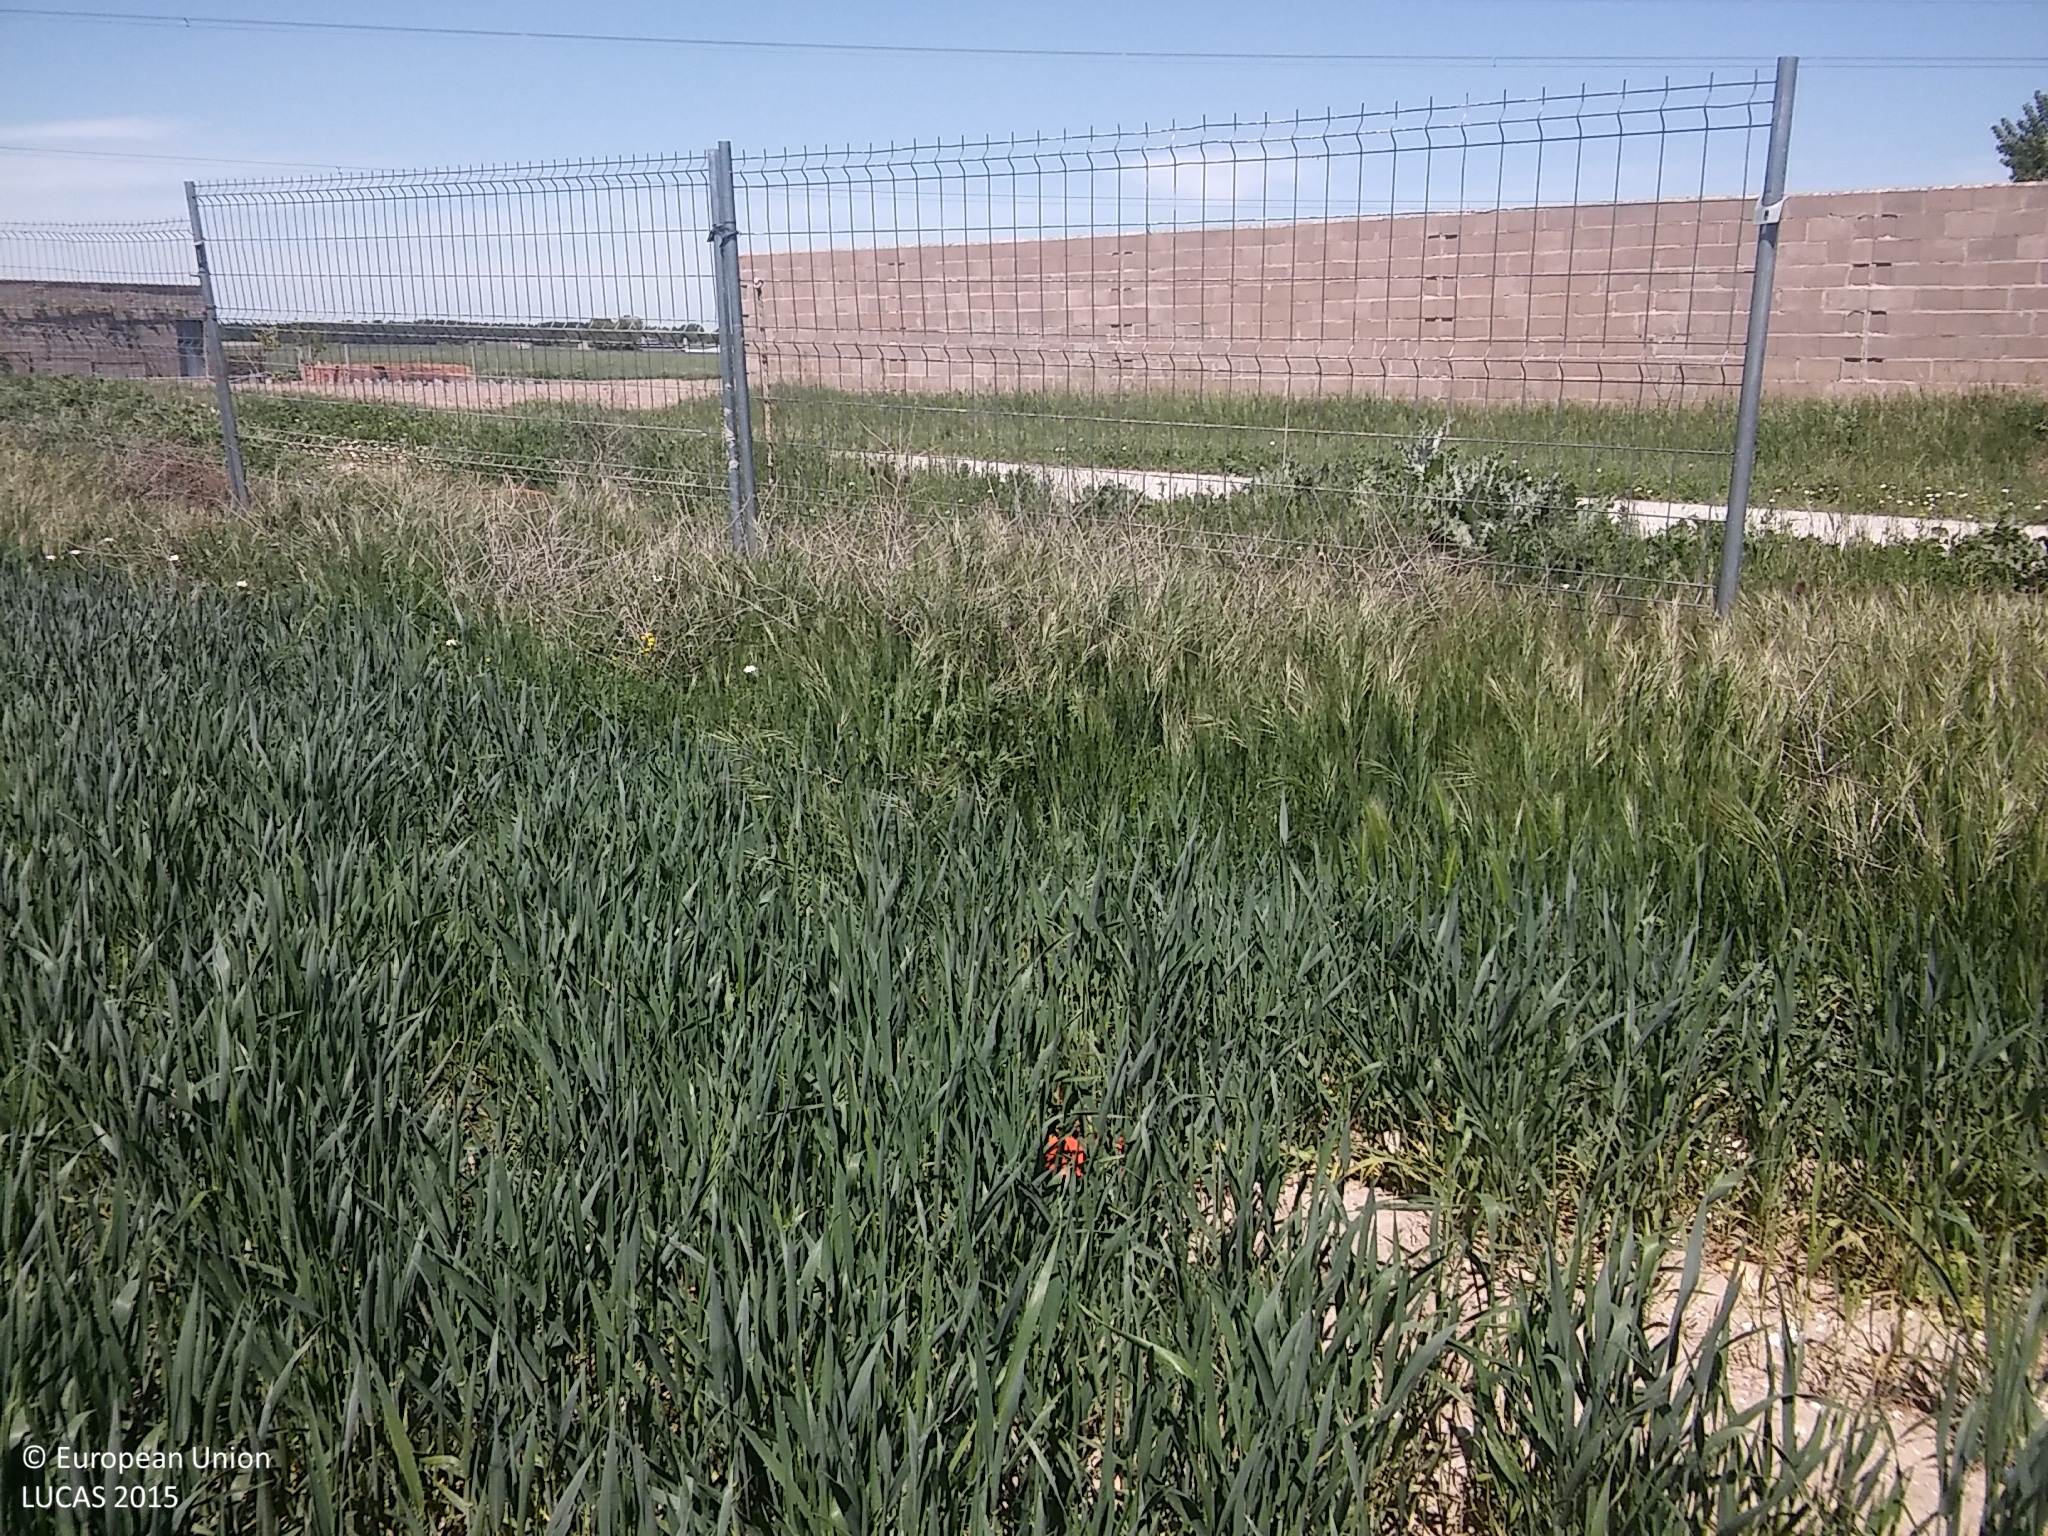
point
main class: Cropland
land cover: Common wheat
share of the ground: > 75 %
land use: Agriculture (excluding fallow land and kitchen gardens)
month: May
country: ES
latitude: 41.2646
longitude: -3.9335
